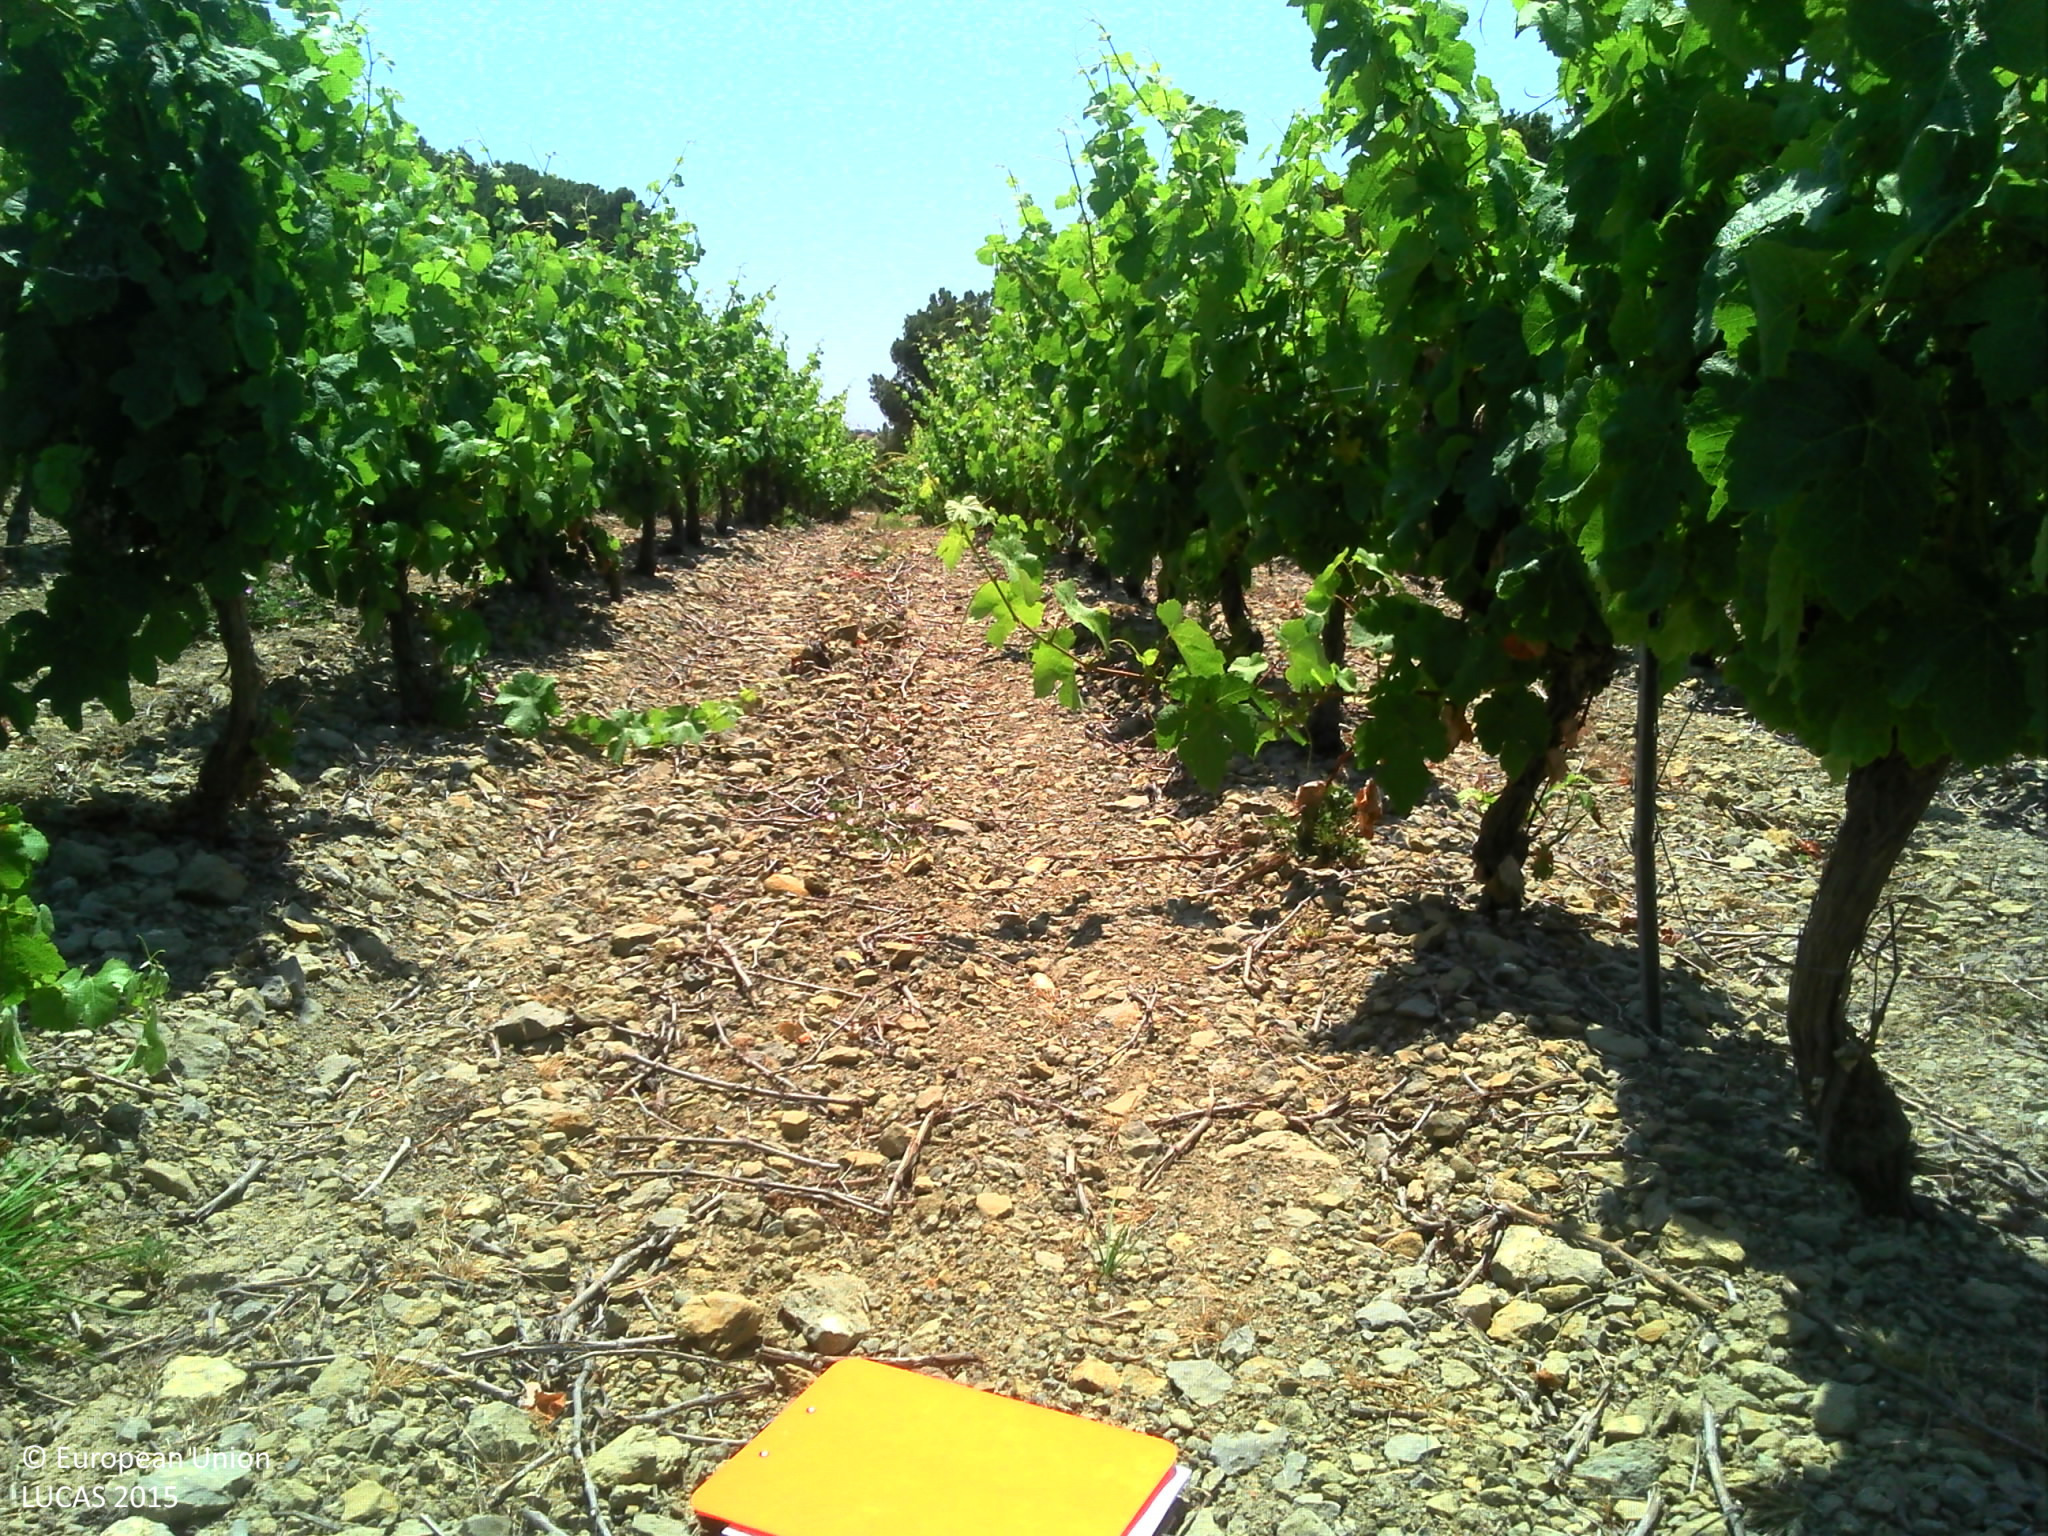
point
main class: Cropland
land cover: Vineyards
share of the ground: 50 - 75 %
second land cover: Other bare soil
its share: > 75 %
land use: Agriculture (excluding fallow land and kitchen gardens)
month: June
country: FR
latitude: 43.1260
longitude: 3.1145
